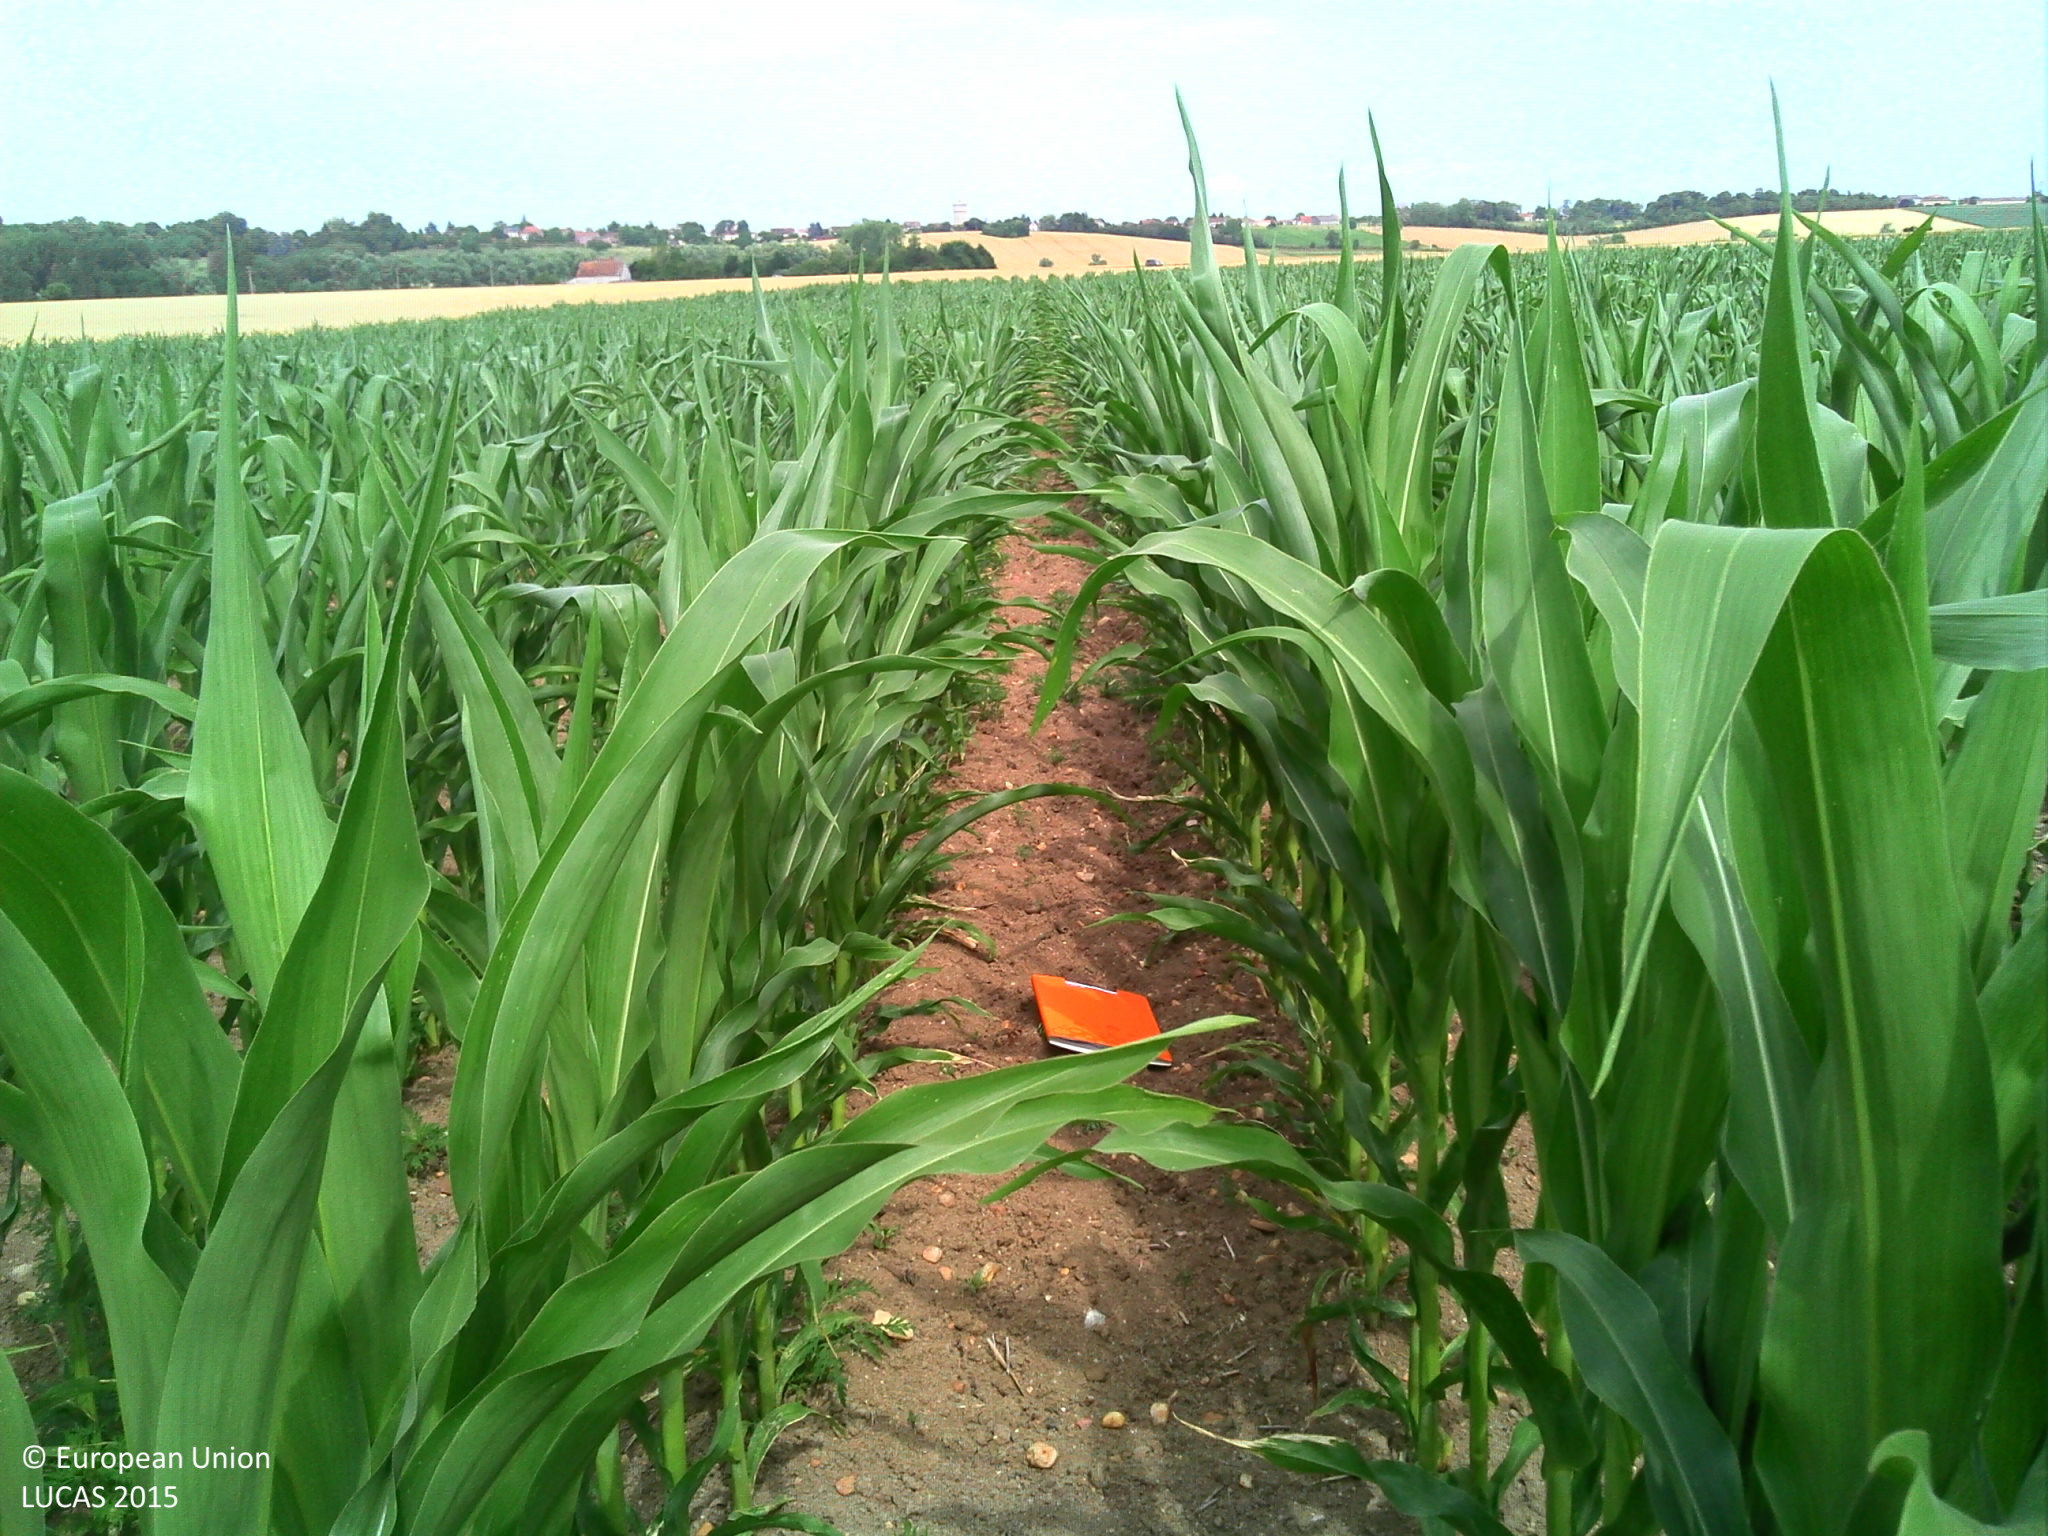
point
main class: Cropland
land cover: Maize
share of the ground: > 75 %
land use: Agriculture (excluding fallow land and kitchen gardens)
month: July
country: FR
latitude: 46.1578
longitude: 3.2785
